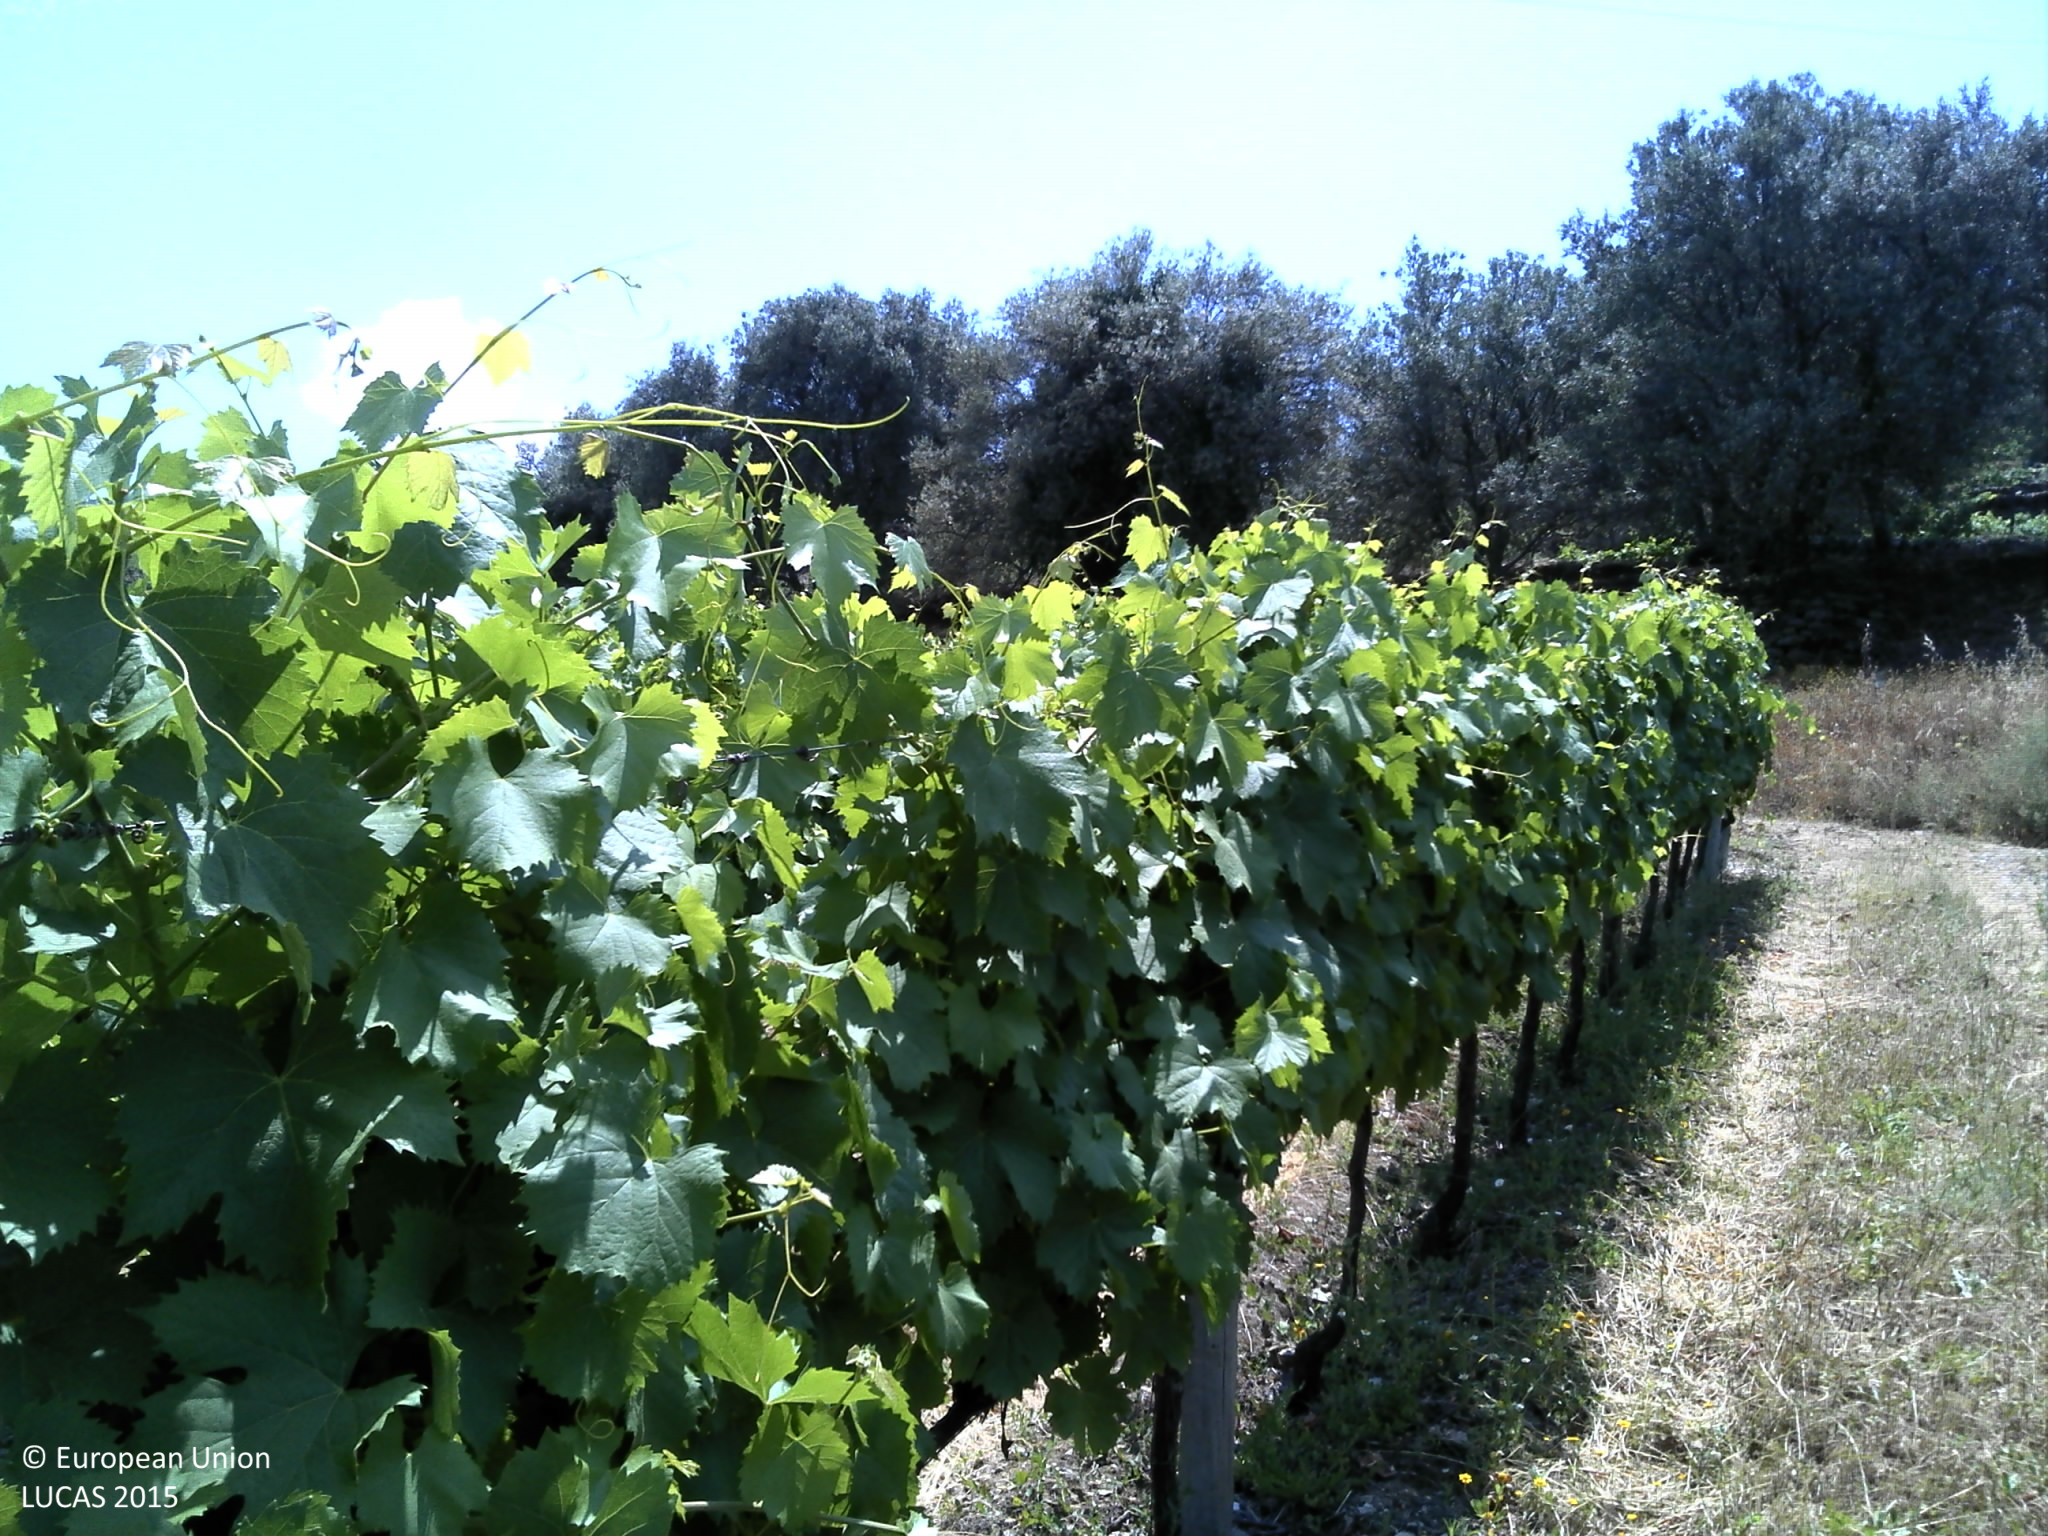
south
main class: Cropland
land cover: Vineyards
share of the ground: 10 - 25 %
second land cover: Spontaneously vegetated surfaces
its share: 50 - 75 %
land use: Agriculture (excluding fallow land and kitchen gardens)
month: June
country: PT
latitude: 41.1963
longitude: -7.5689
